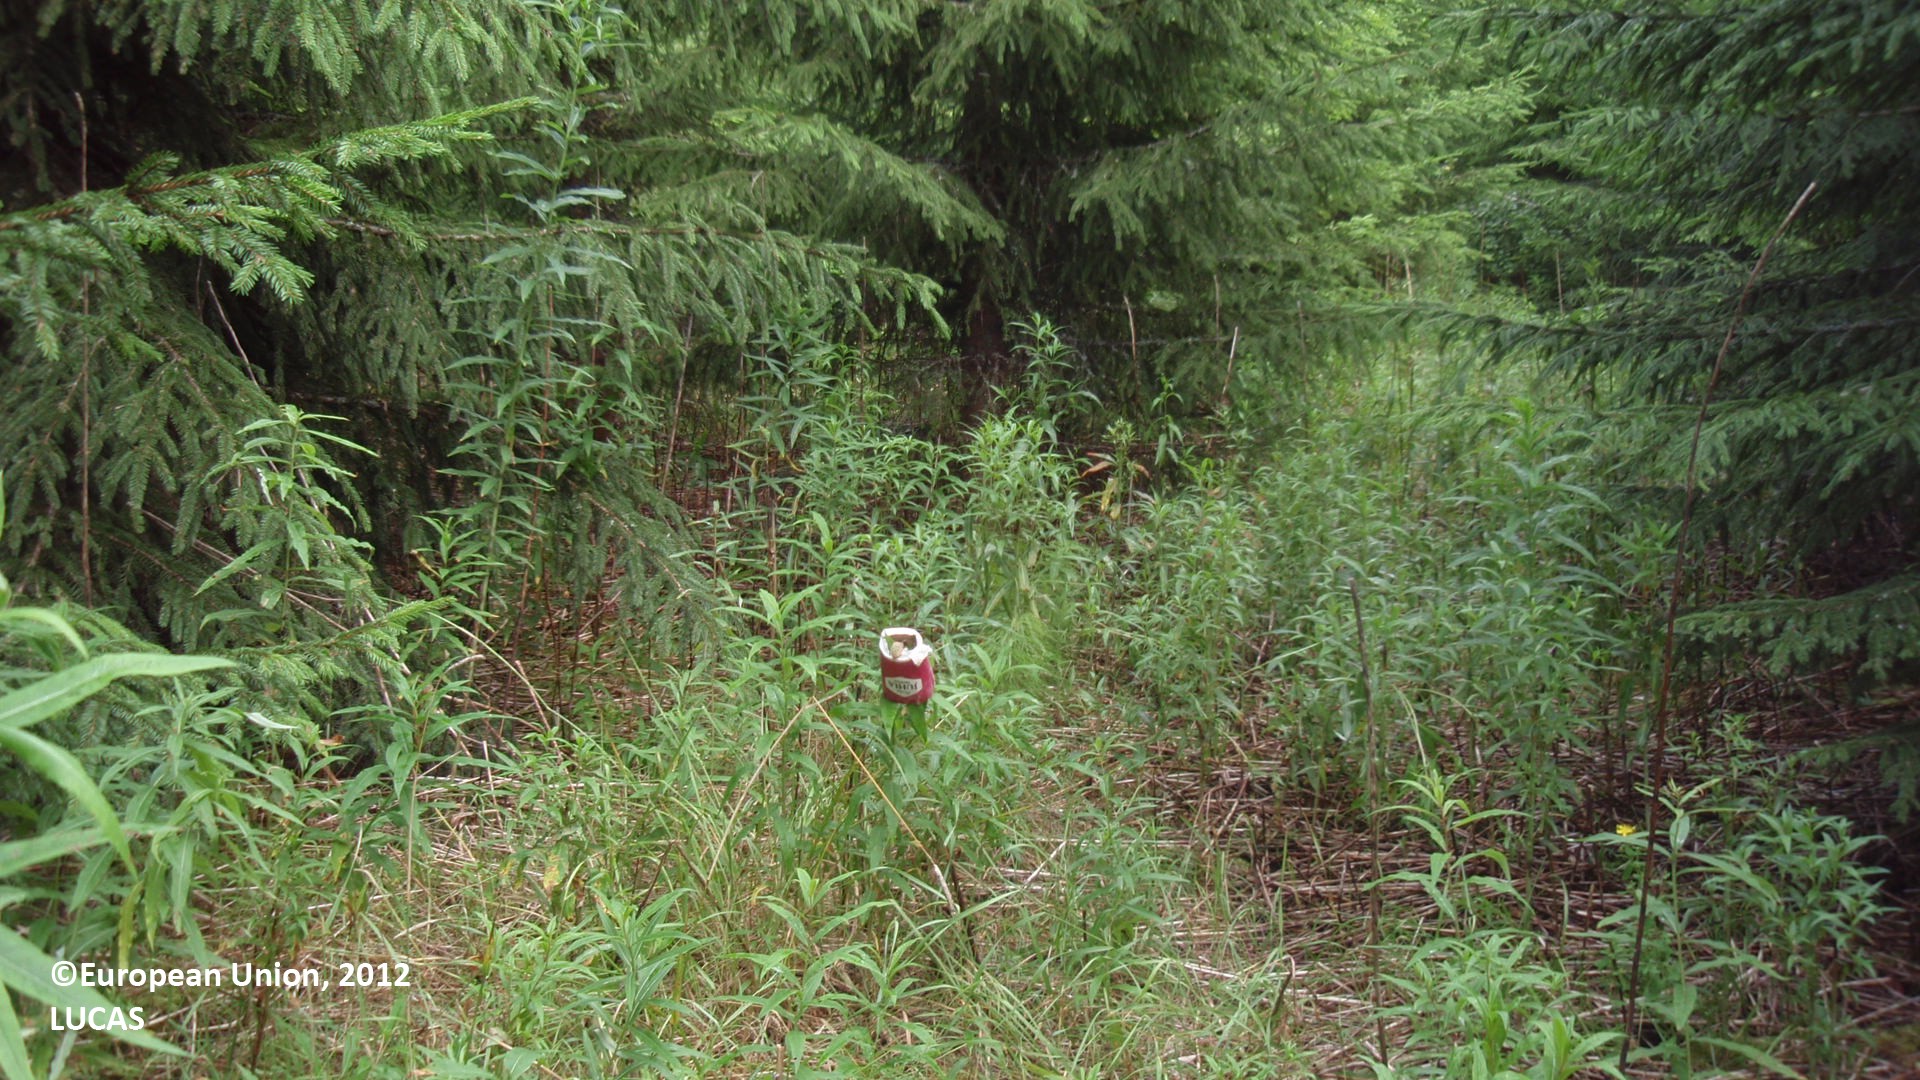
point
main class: Woodland
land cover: Spruce dominated coniferous woodland
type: boreal forest
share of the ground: > 75 %
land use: Forestry
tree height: > 5 m
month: August
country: FI
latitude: 61.0461
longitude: 26.9605
